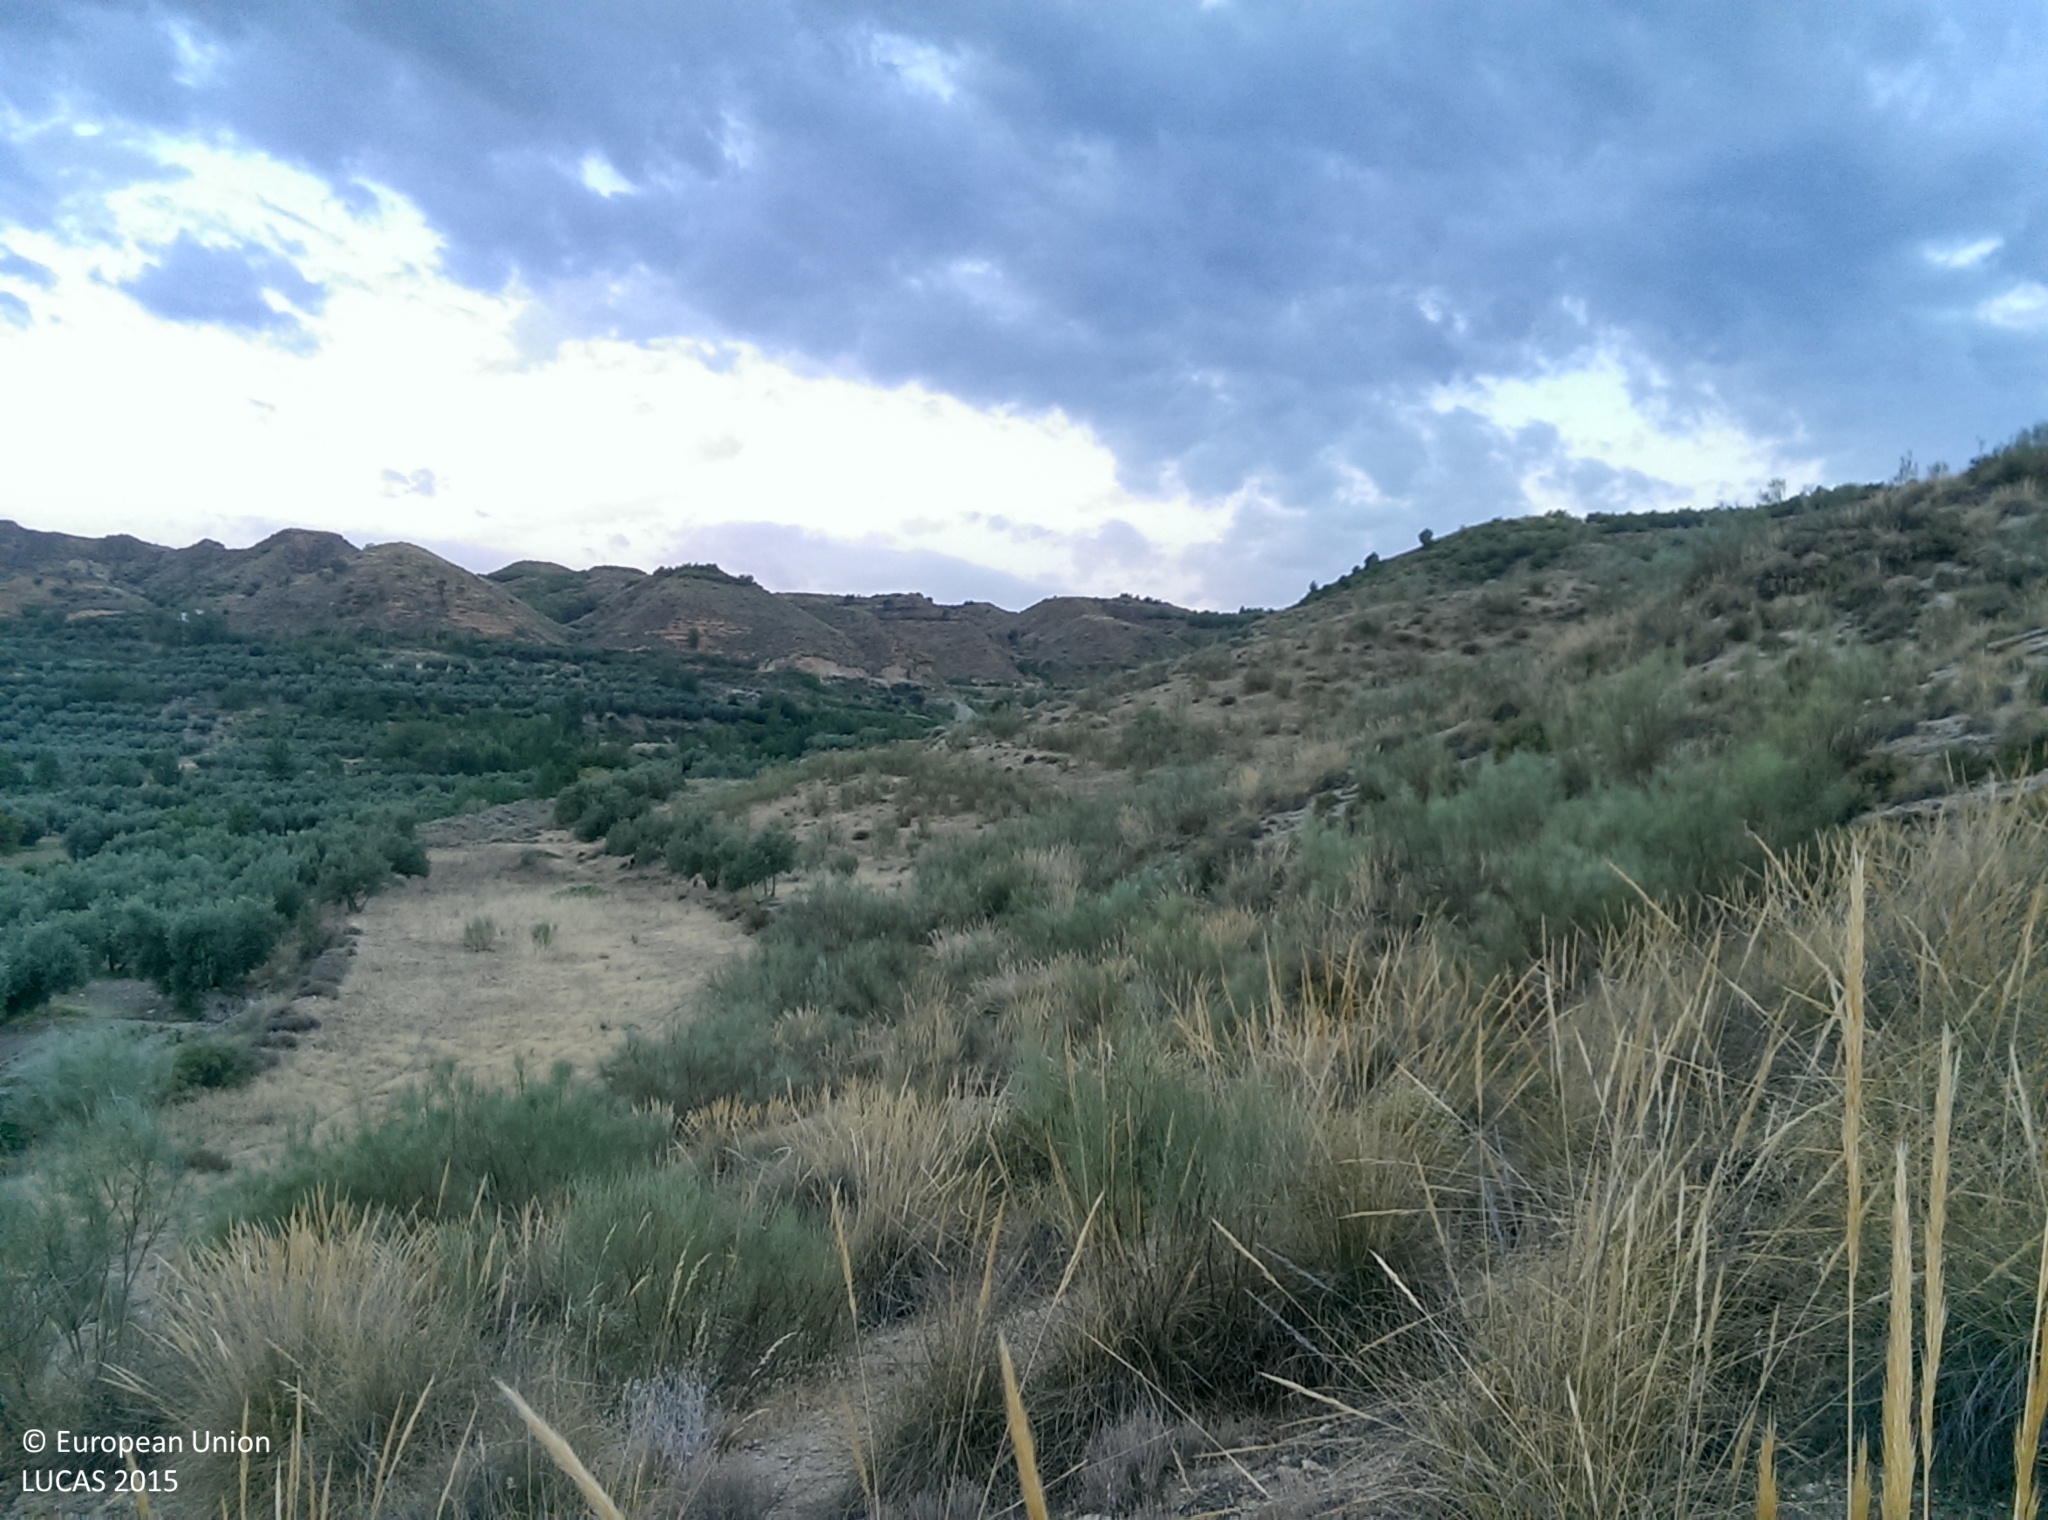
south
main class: Grassland
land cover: Grassland without tree/shrub cover
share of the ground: > 75 %
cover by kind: herbaceous plants 75 %, unconsolidated bare surface 20 %, shrubs 5 %
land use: Semi-natural and natural areas not in use
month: July
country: ES
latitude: 37.3120
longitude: -3.2461
